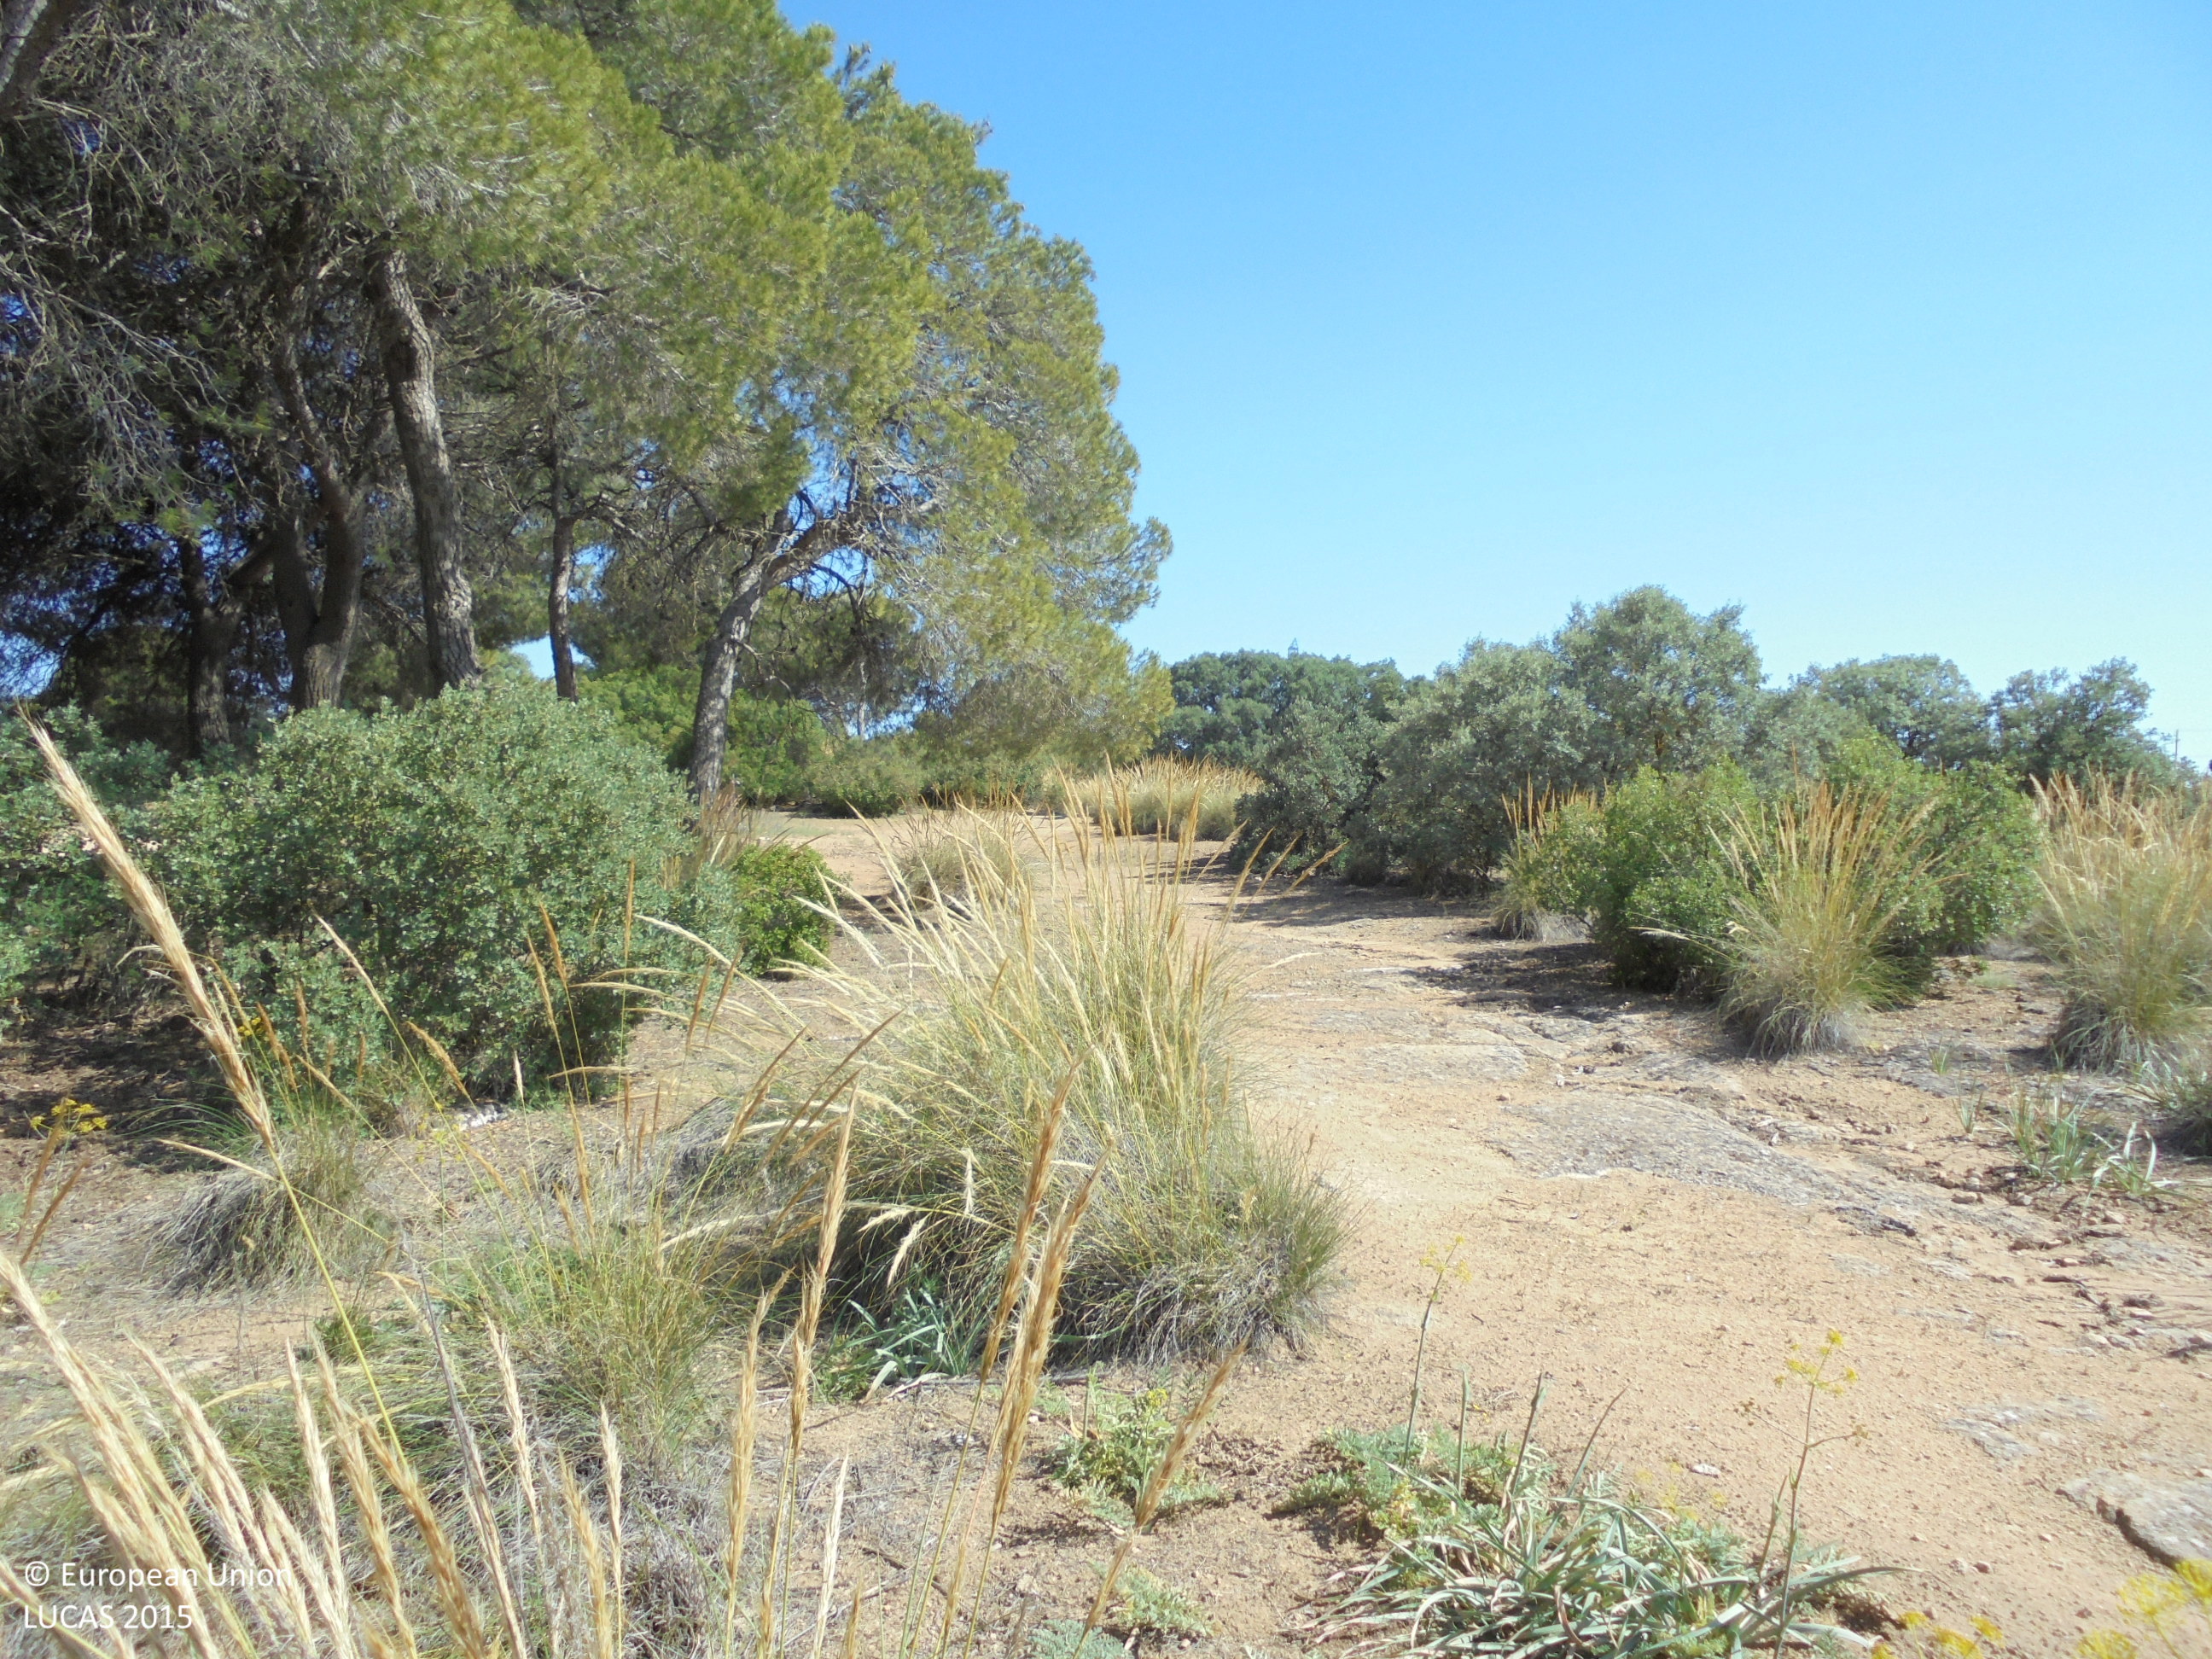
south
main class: Woodland
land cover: Pine dominated coniferous woodland
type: coniferous forest of the mediterranean region
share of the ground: 50 - 75 %
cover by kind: coniferous forest trees 60 %, shrubs 30 %, unconsolidated bare surface 10 %
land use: Semi-natural and natural areas not in use
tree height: > 5 m
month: June
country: ES
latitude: 38.7635
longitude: -1.6774
